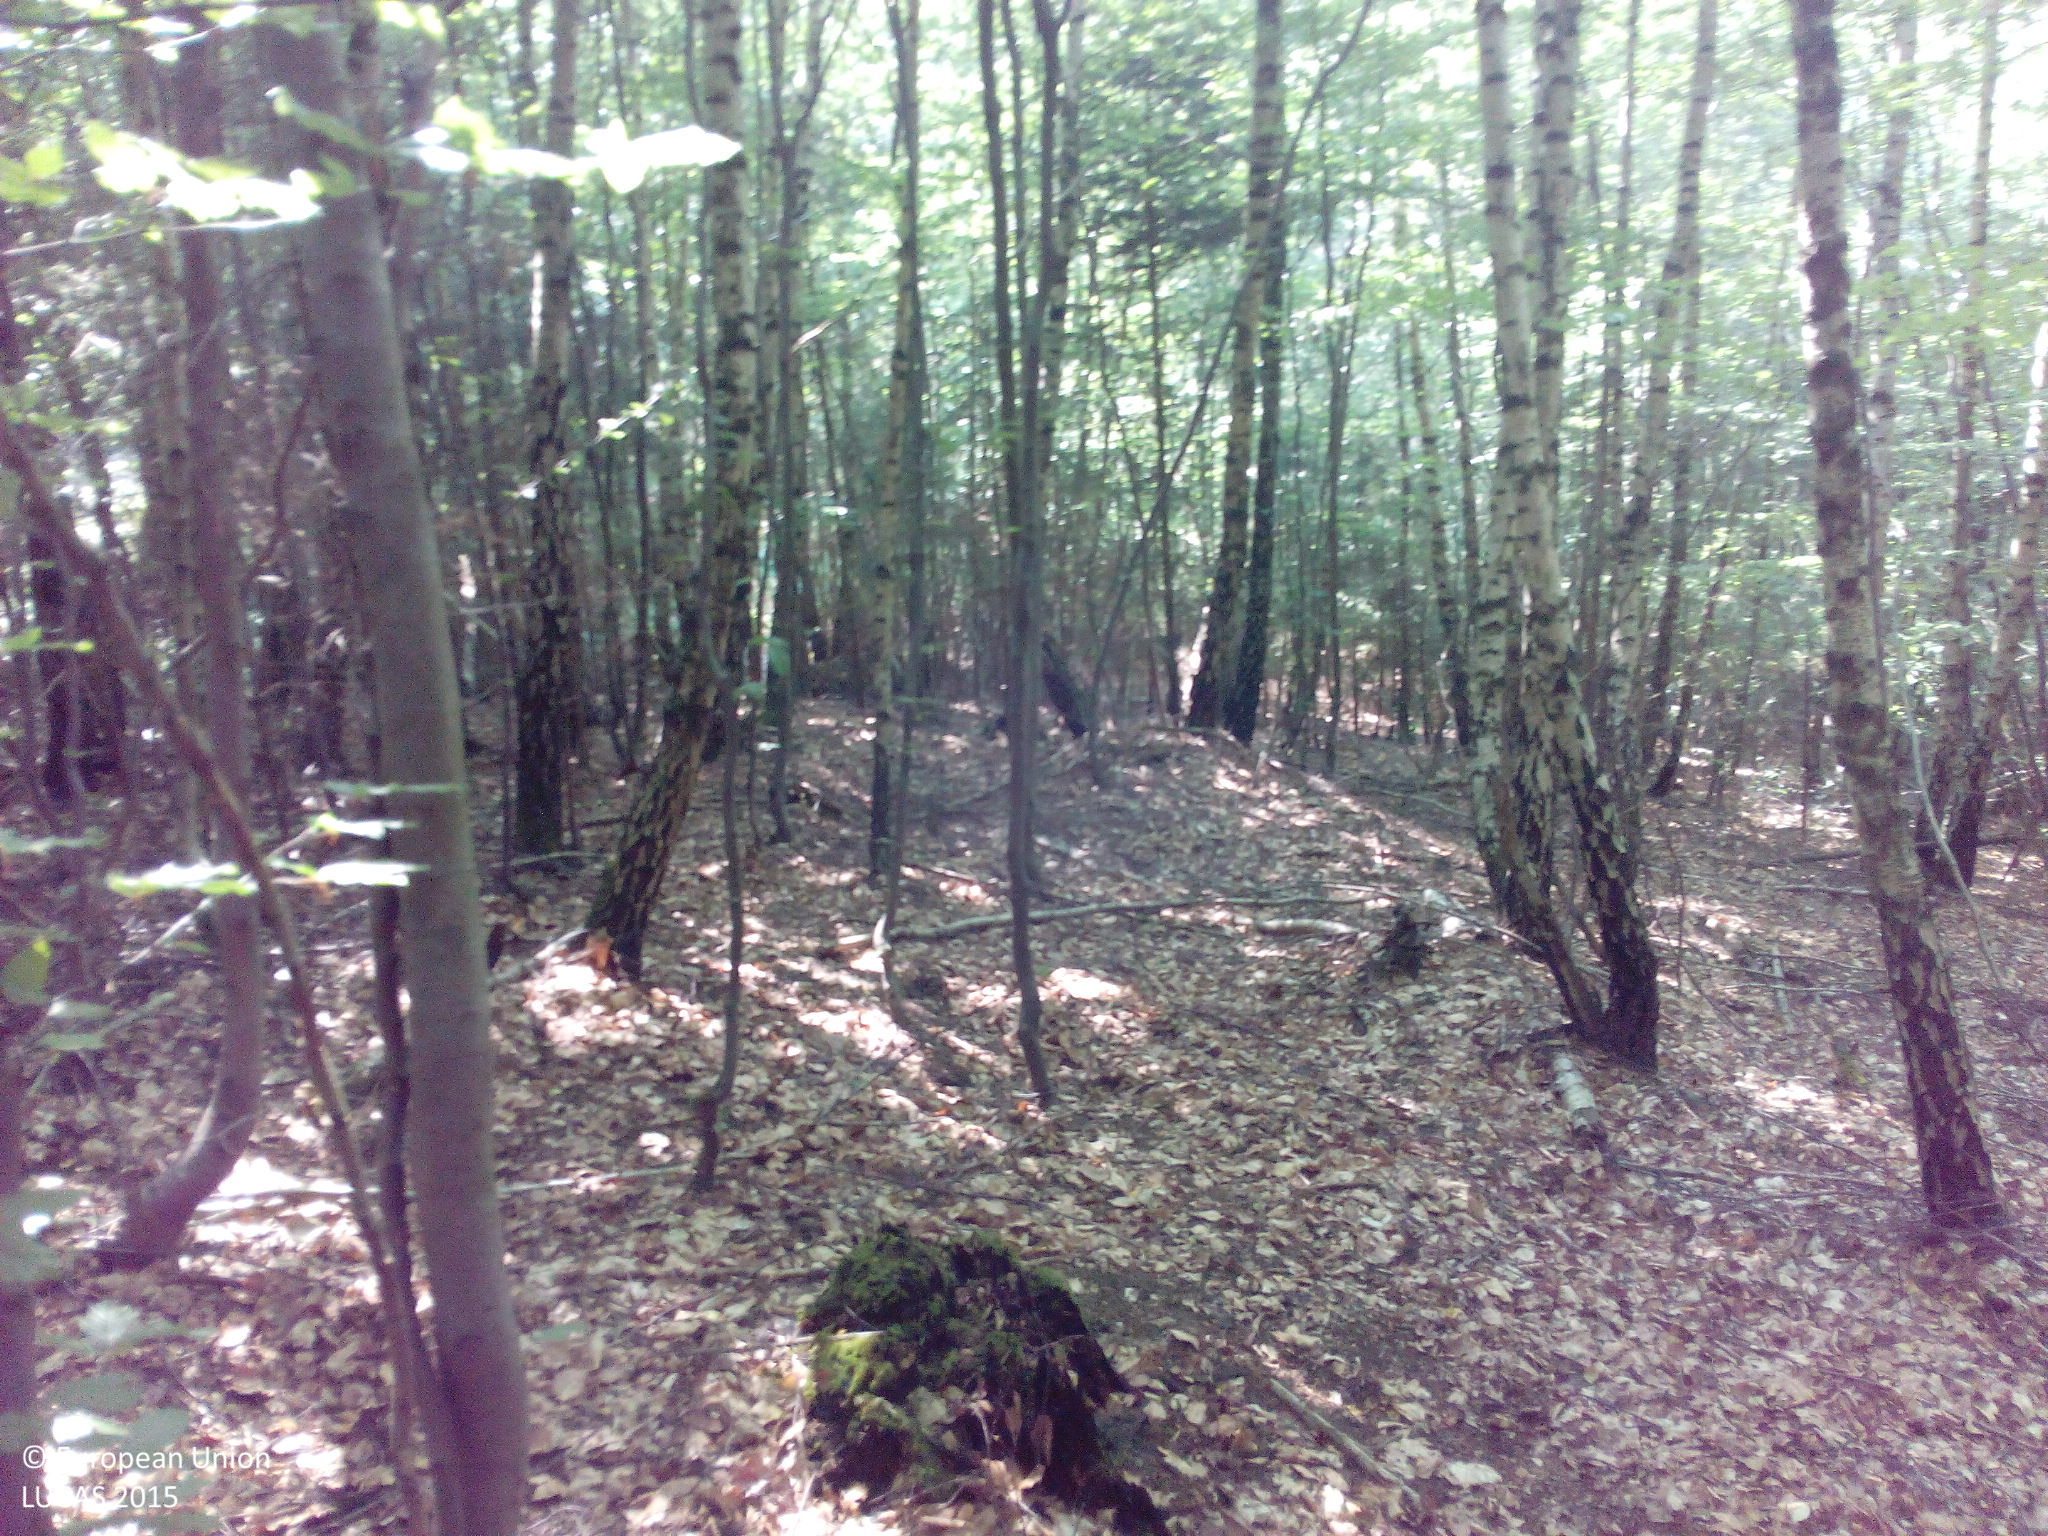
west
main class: Woodland
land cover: Broadleaved woodland
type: mesophytic deciduous forest
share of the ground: > 75 %
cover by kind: broadleaved forest trees 85 %, coniferous forest trees 15 %
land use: Forestry
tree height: > 5 m
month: July
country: DE
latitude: 49.3015
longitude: 7.0986
